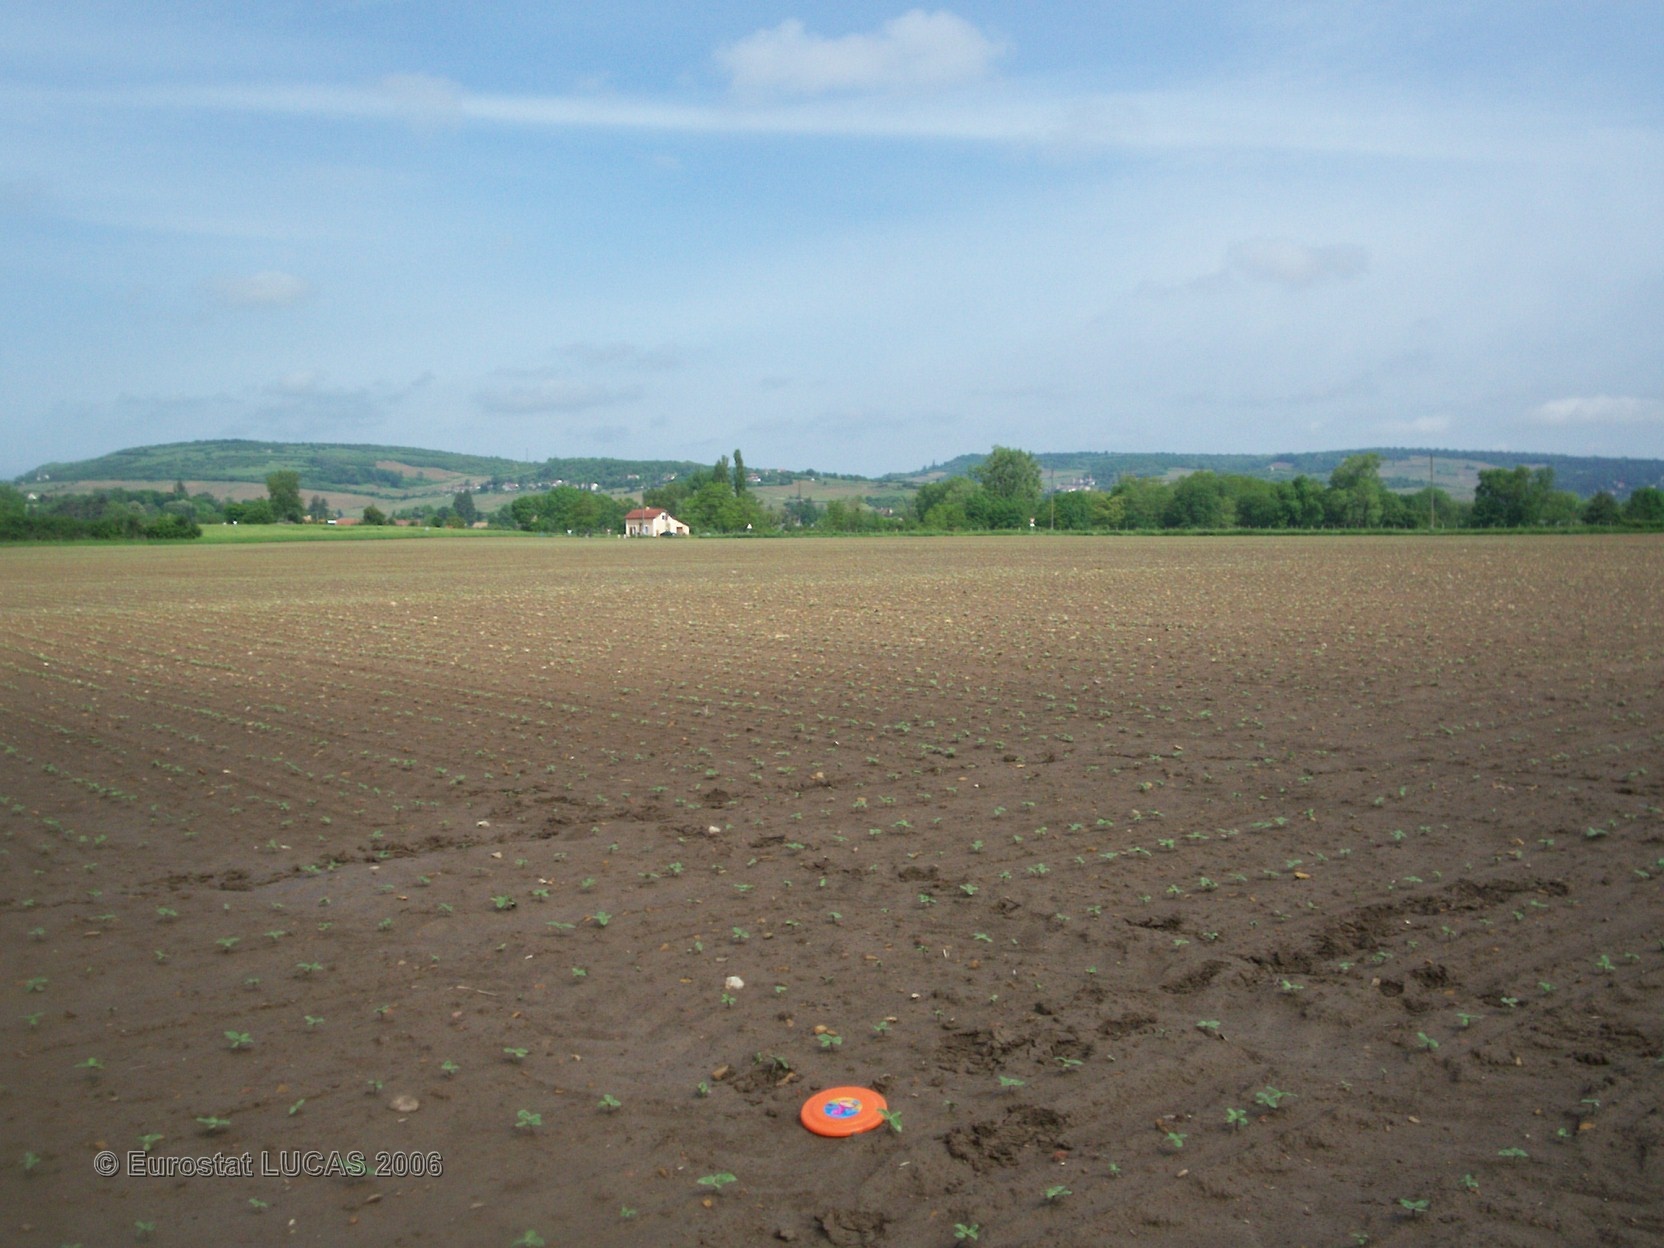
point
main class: Cropland
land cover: Sunflower
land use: Agriculture (excluding fallow land and kitchen gardens)
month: May
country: FR
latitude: 46.7445
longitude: 4.7263
